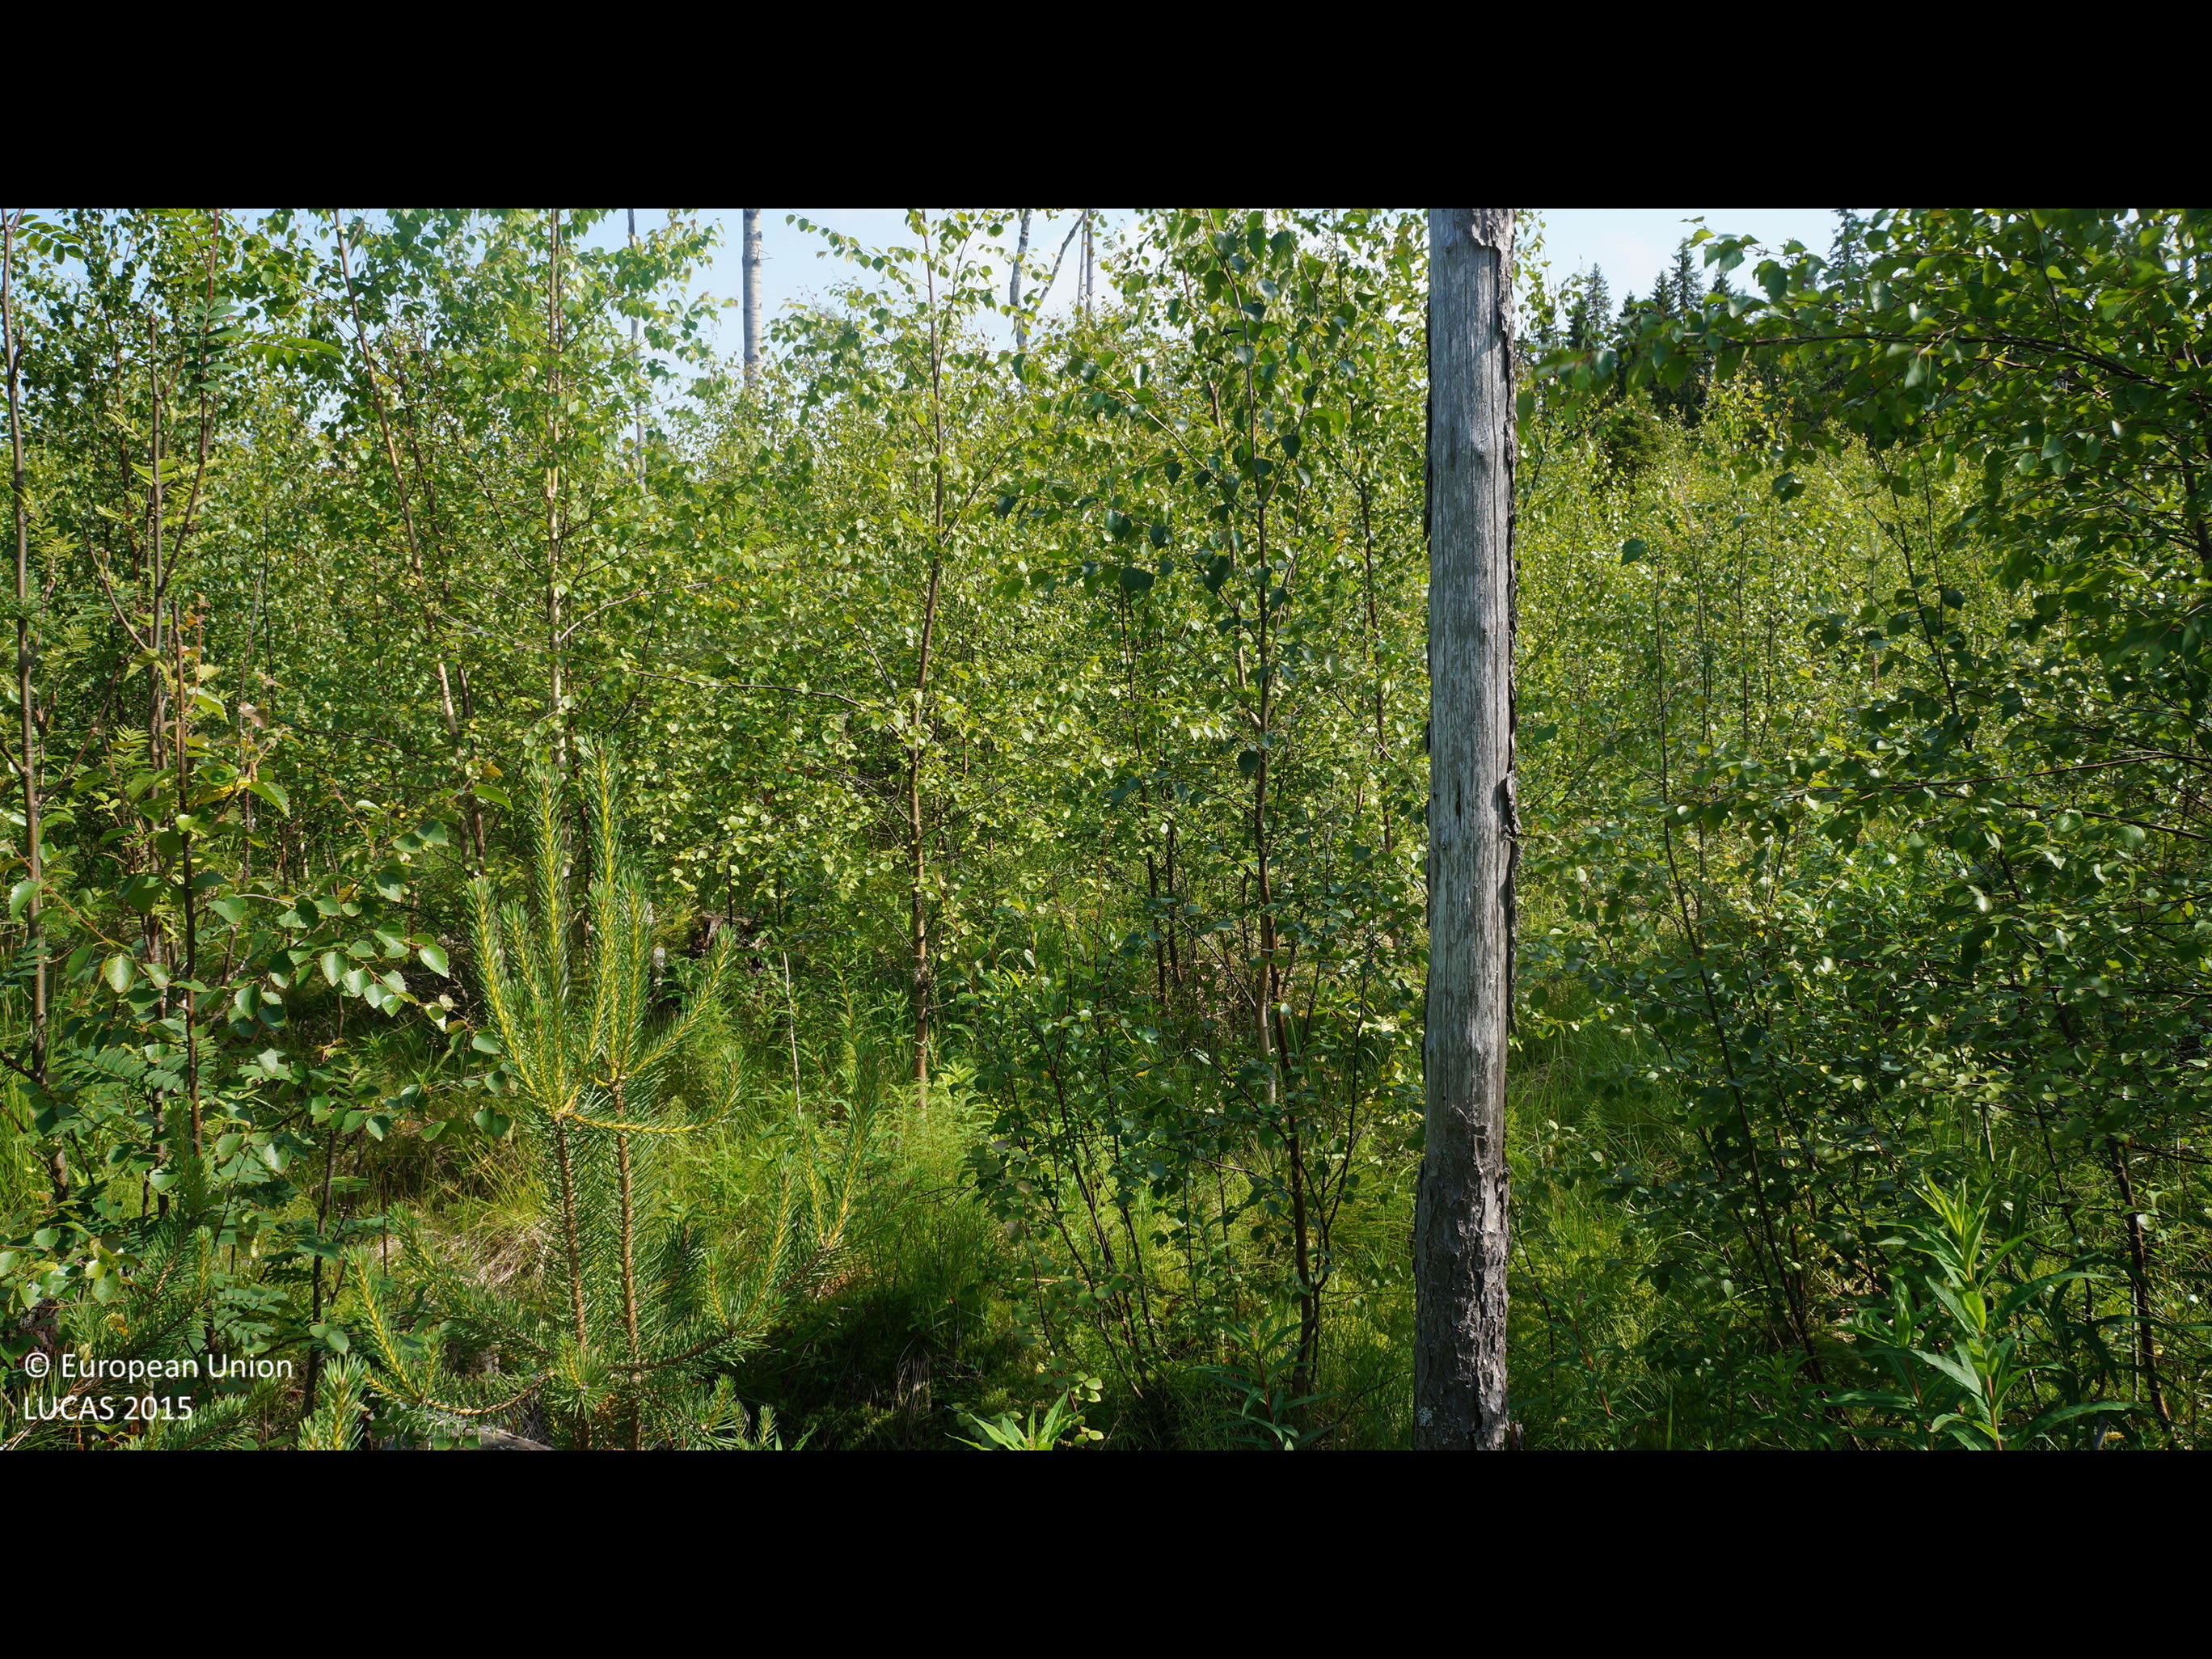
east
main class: Woodland
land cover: Broadleaved woodland
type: boreal forest
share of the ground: 25 - 50 %
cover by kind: shrubs 50 %, broadleaved forest trees 30 %, coniferous forest trees 10 %, herbaceous plants 10 %
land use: Forestry
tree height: < 5 m
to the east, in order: Broadleaved woodland; Spruce dominated mixed woodland; Broadleaved woodland; Spruce dominated coniferous woodland; Ditches and canals; Spruce dominated coniferous woodland
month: July
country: FI
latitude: 64.1953
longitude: 24.4220
